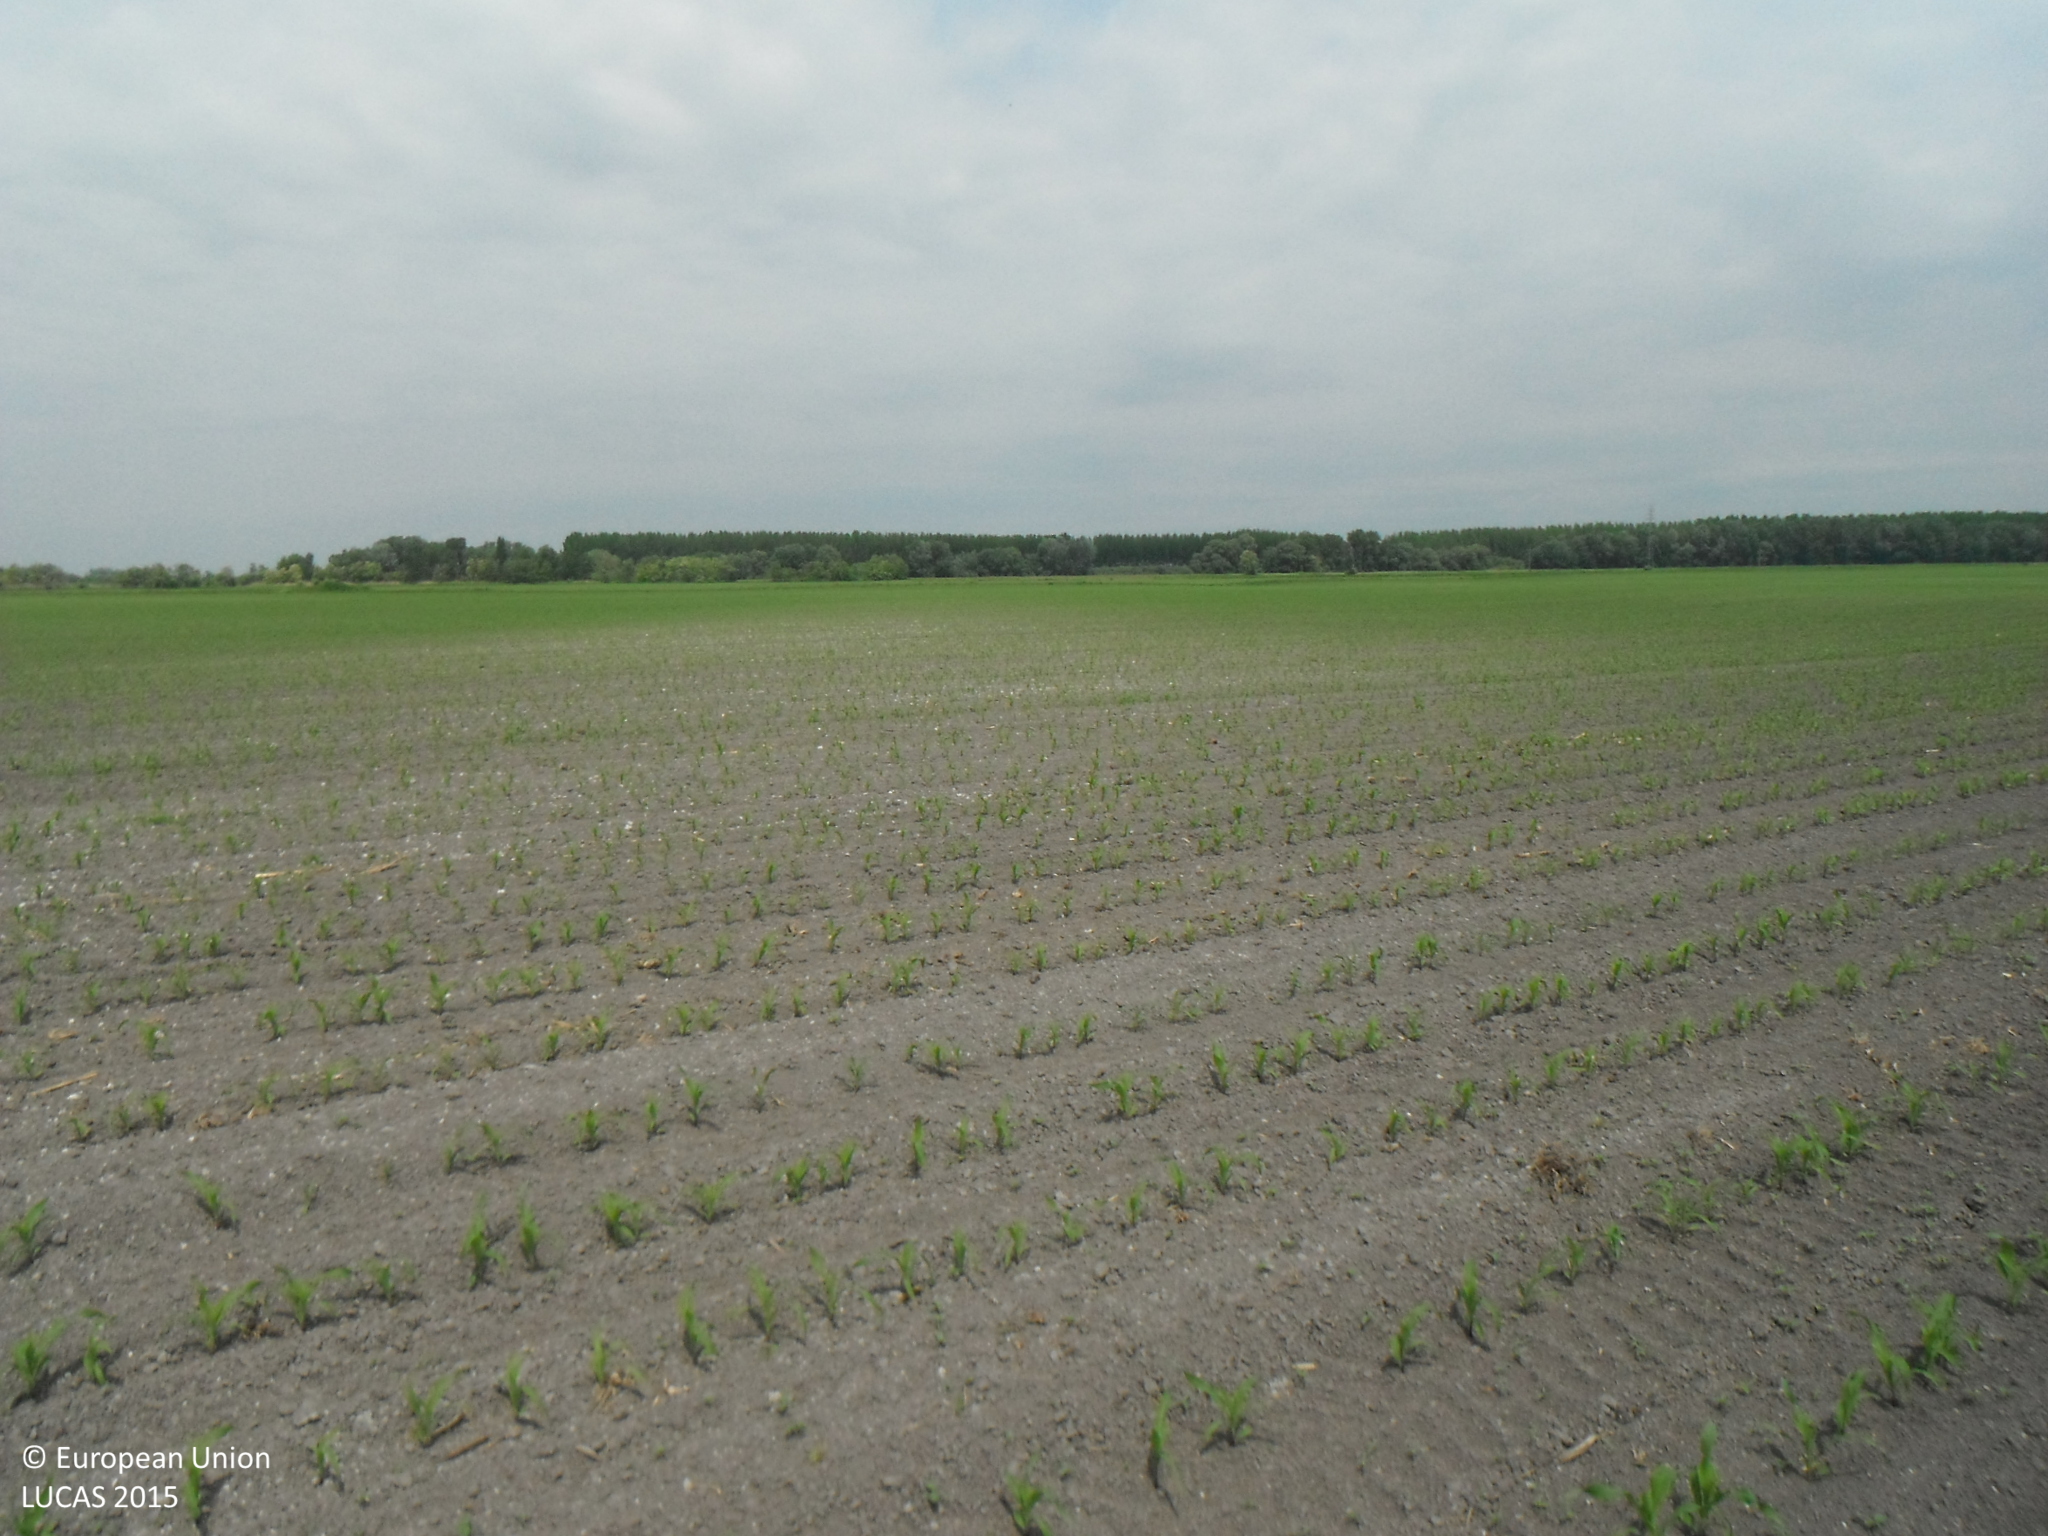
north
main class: Cropland
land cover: Maize
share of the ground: < 10 %
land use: Agriculture (excluding fallow land and kitchen gardens)
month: May
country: SK
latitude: 47.8978
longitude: 17.7285
